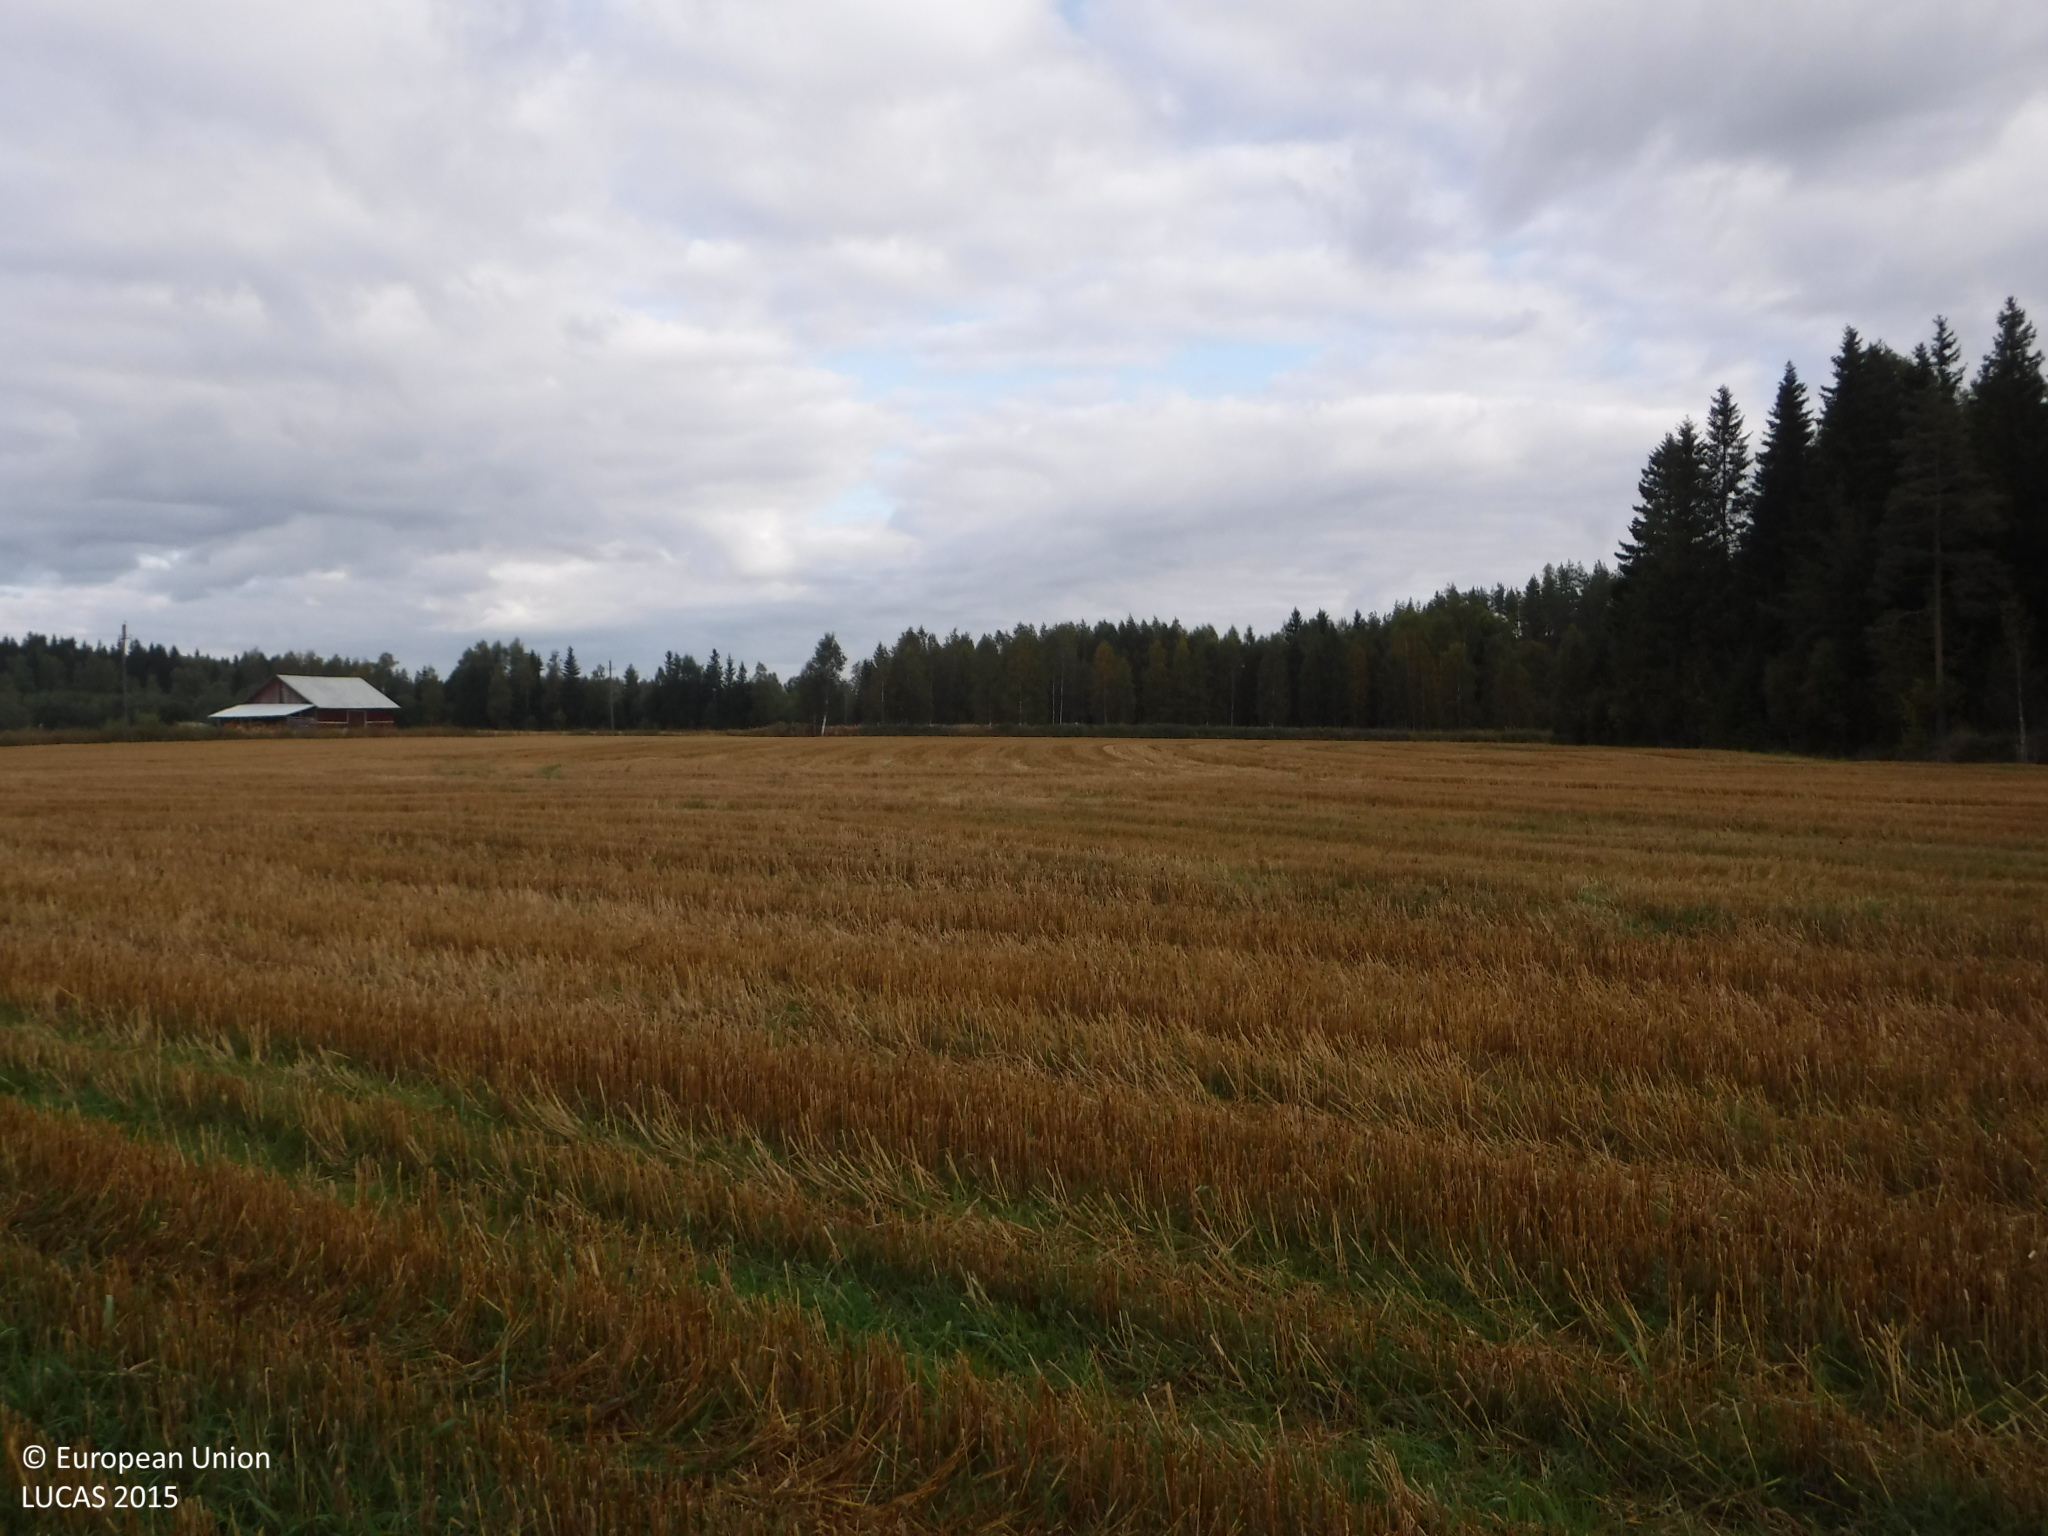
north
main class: Cropland
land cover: Barley
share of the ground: 25 - 50 %
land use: Agriculture (excluding fallow land and kitchen gardens)
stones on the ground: < 10 %
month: September
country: FI
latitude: 61.7458
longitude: 22.2339
